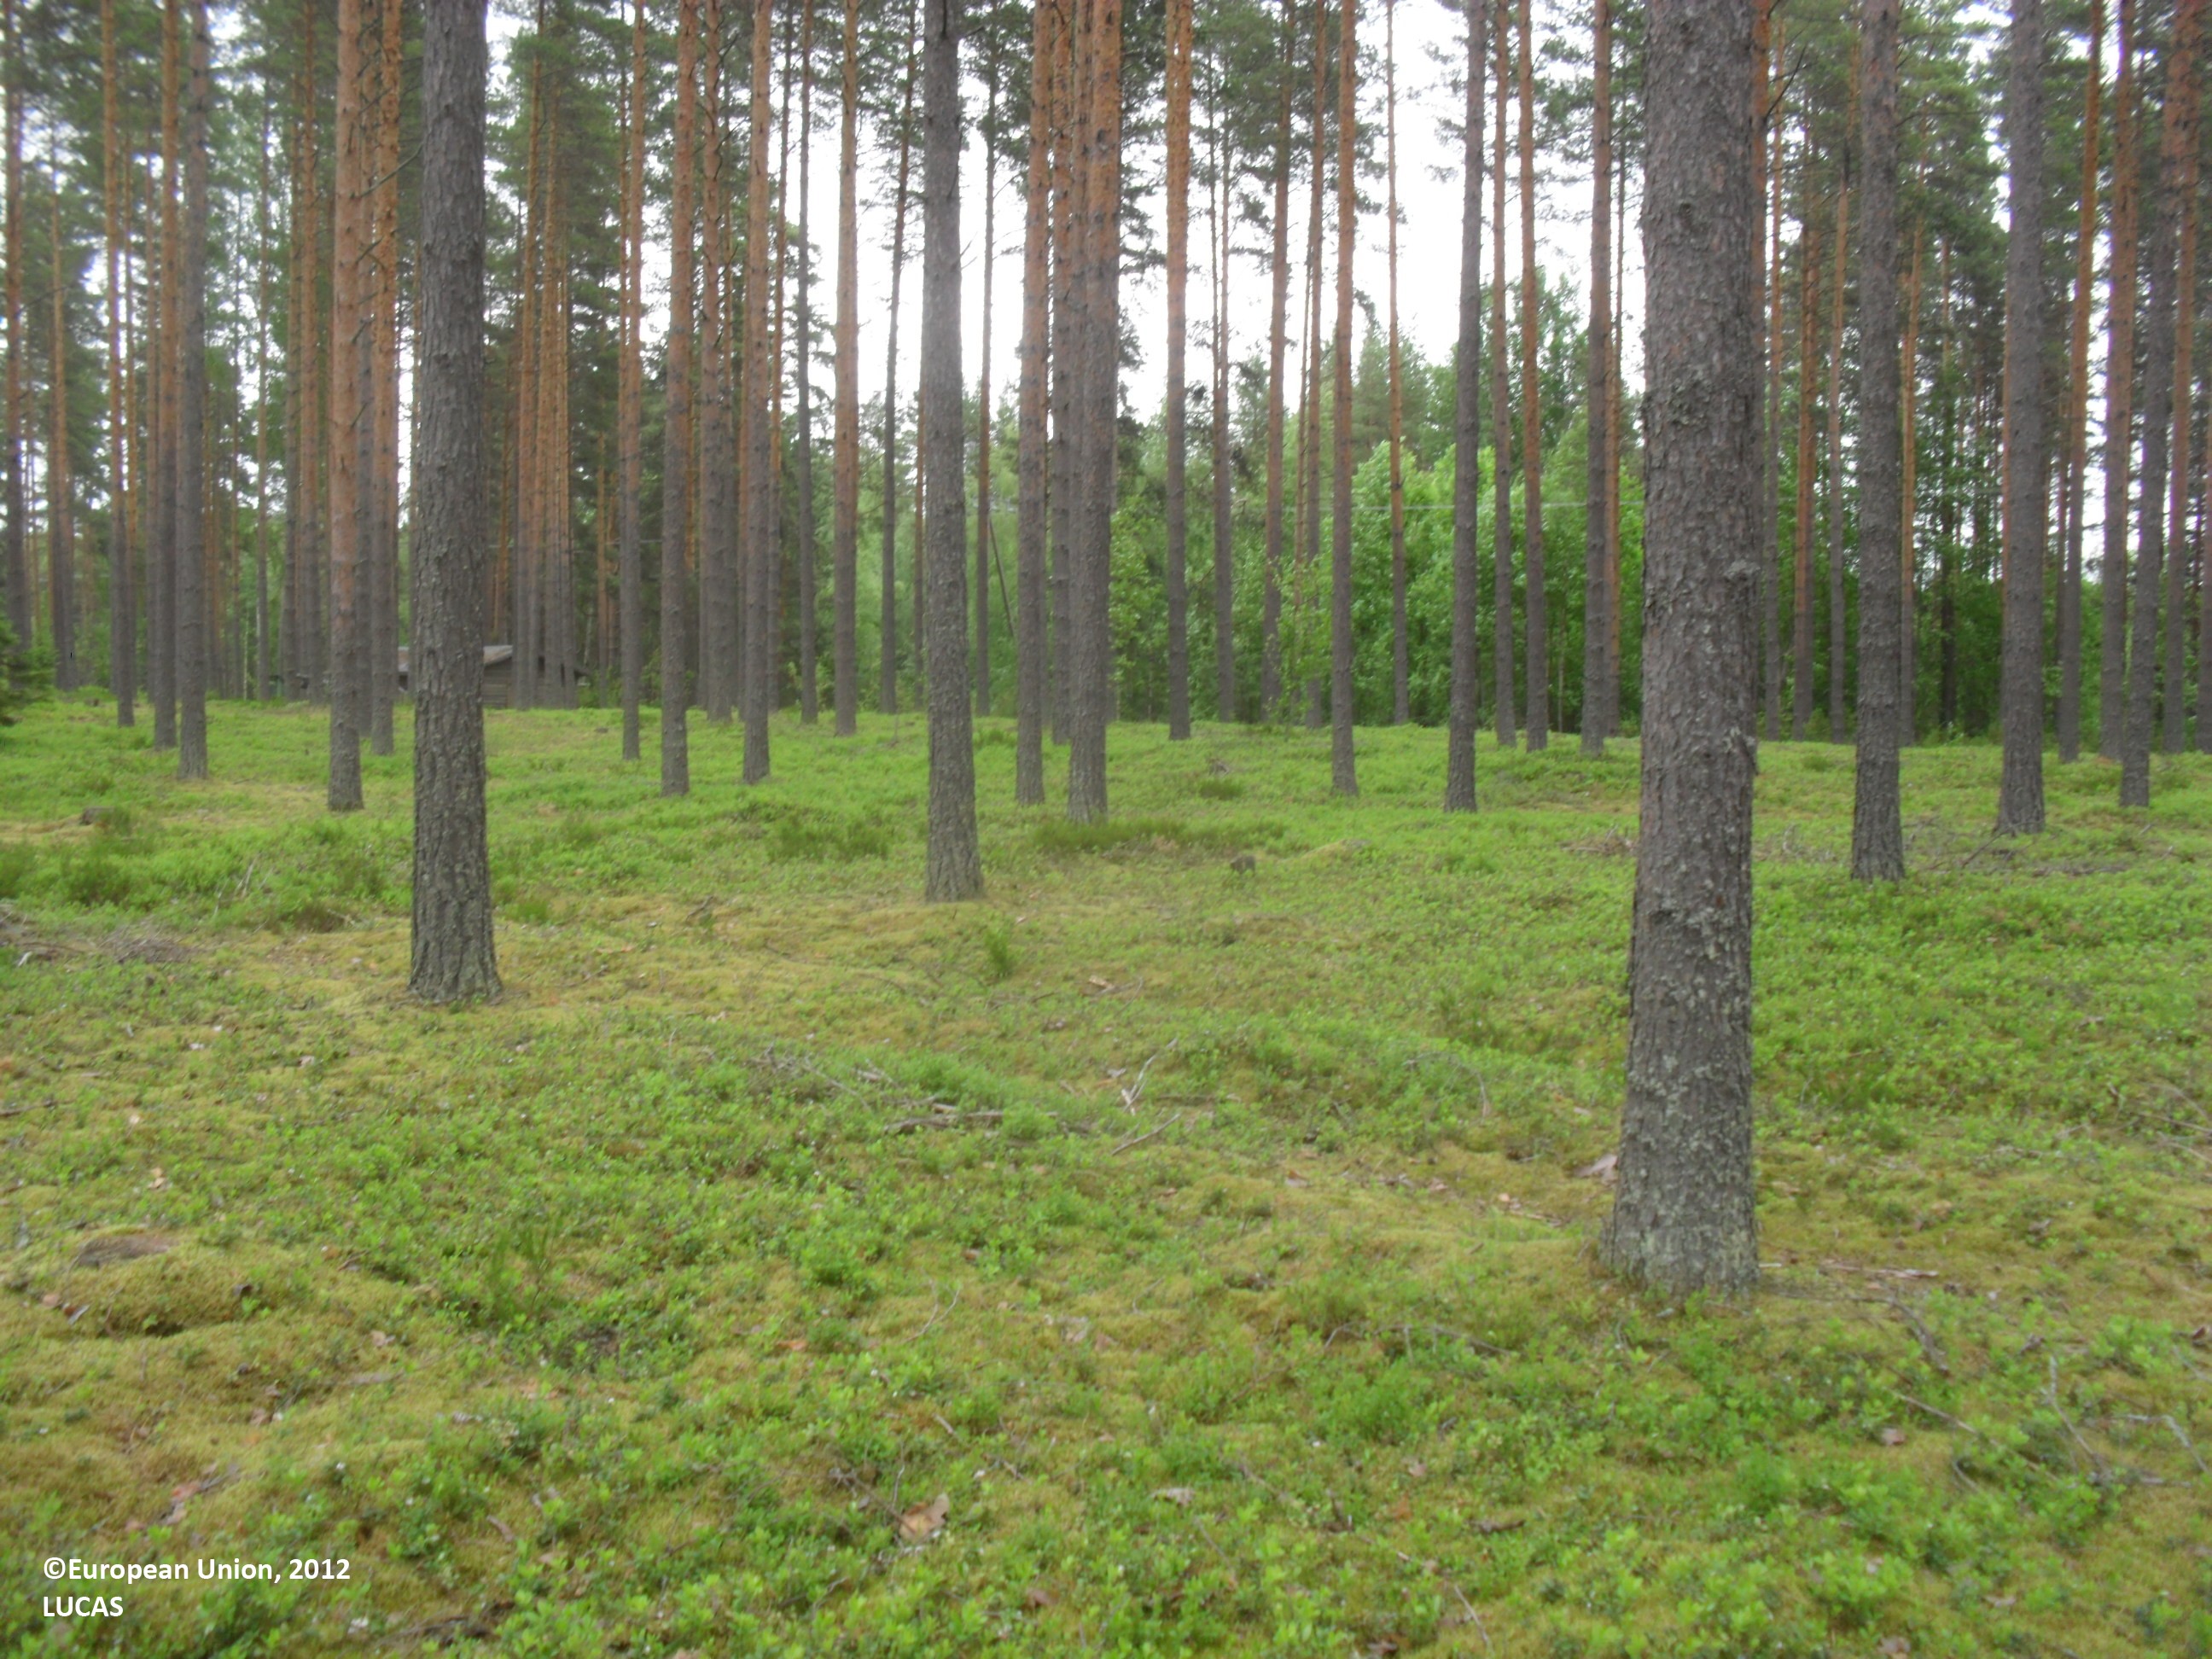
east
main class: Woodland
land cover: Pine dominated coniferous woodland
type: boreal forest
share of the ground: 25 - 50 %
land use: Forestry
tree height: > 5 m
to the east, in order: Pine dominated coniferous woodland; Tracks; Pine dominated coniferous woodland; Other mixed woodland; Broadleaved woodland; Inland marshes; Inland water bodies
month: June
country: FI
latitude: 62.9521
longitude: 23.5305
